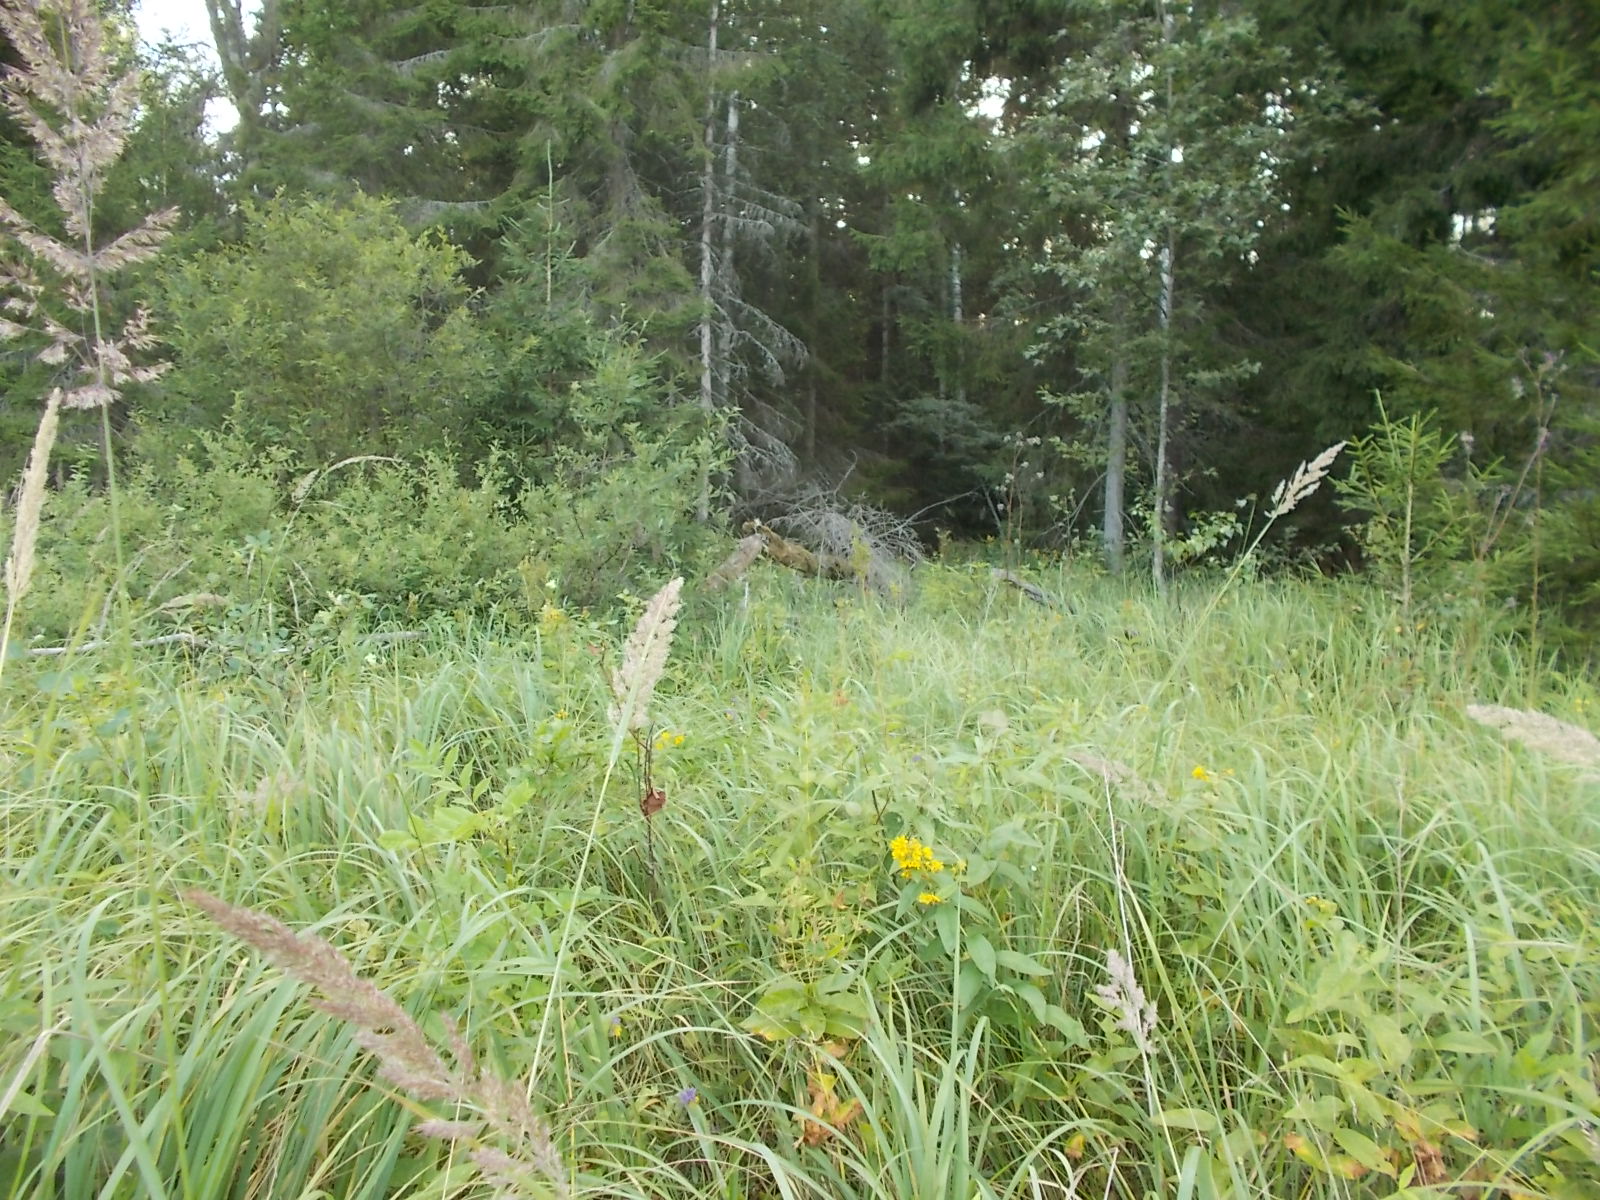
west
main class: Grassland
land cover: Grassland with sparse tree/shrub cover
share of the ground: > 75 %
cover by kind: herbaceous plants 90 %, broadleaved forest trees 5 %, shrubs 5 %
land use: Forestry
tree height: > 5 m
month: August
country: LV
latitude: 57.0895
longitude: 22.0783
